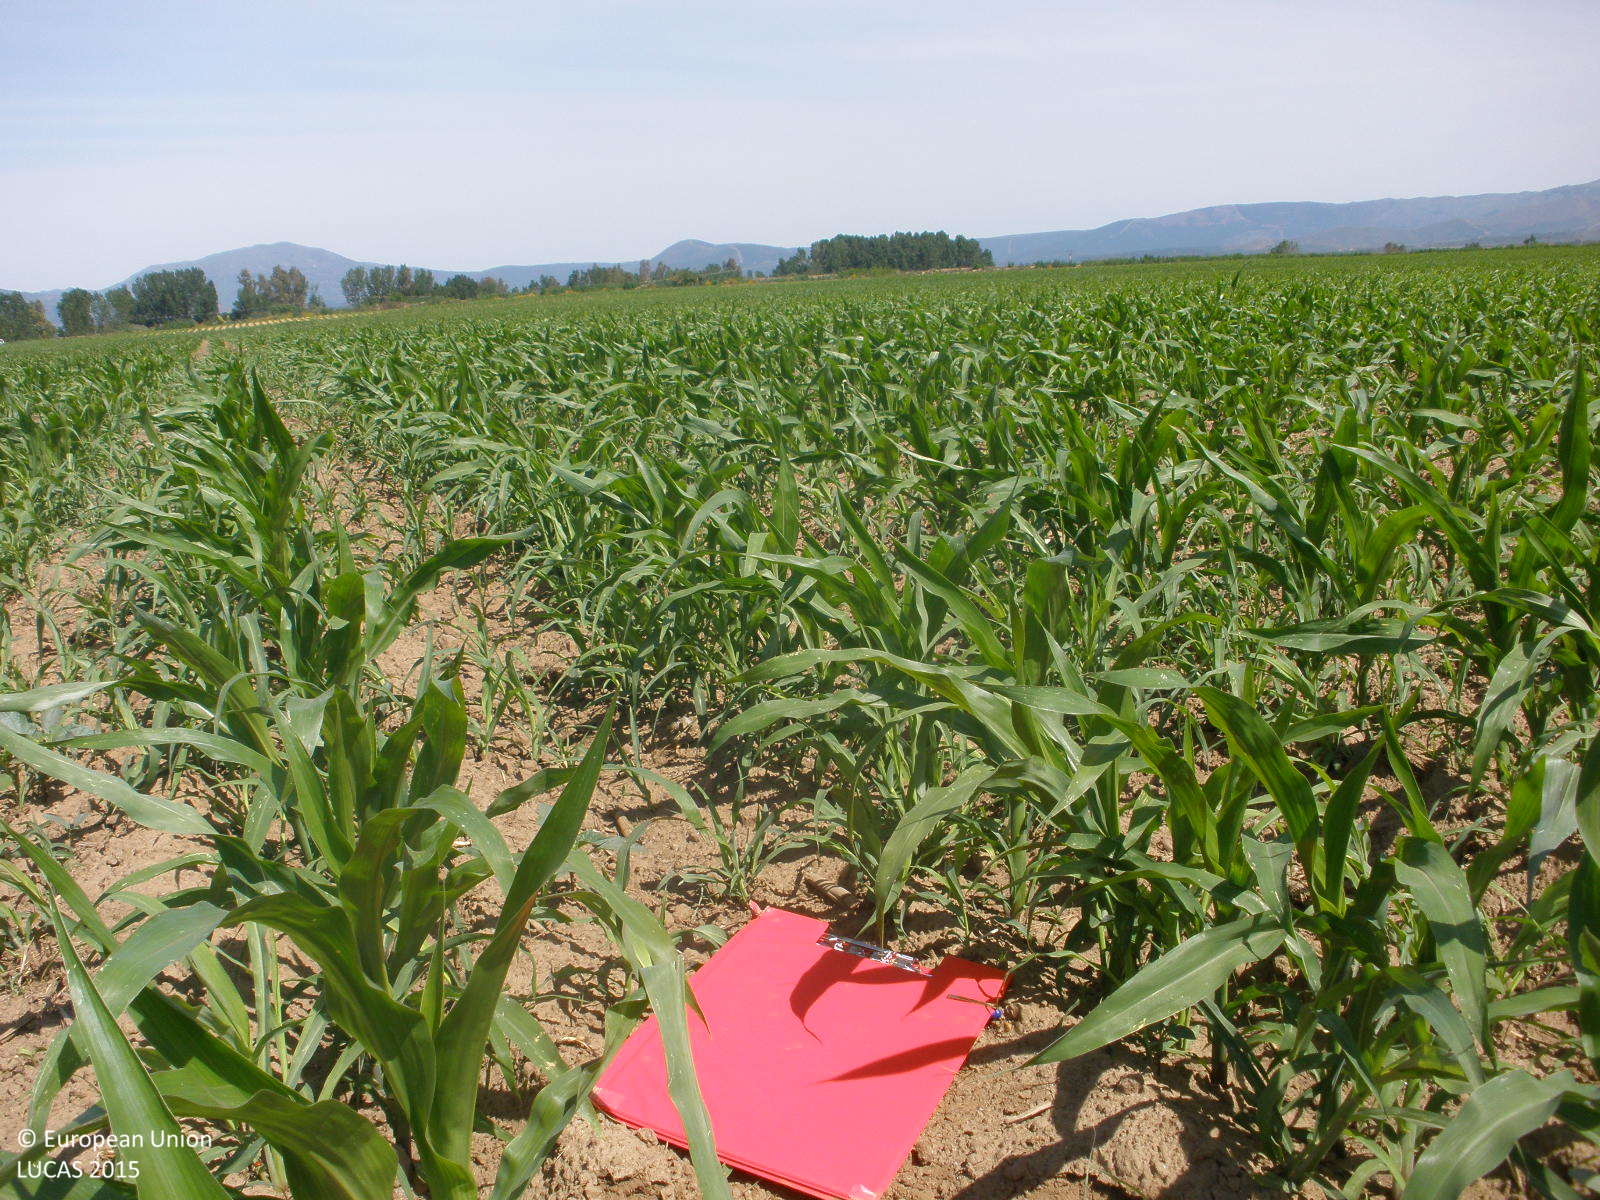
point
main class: Cropland
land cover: Maize
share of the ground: 50 - 75 %
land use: Agriculture (excluding fallow land and kitchen gardens)
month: May
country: ES
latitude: 40.0931
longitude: -6.6098
